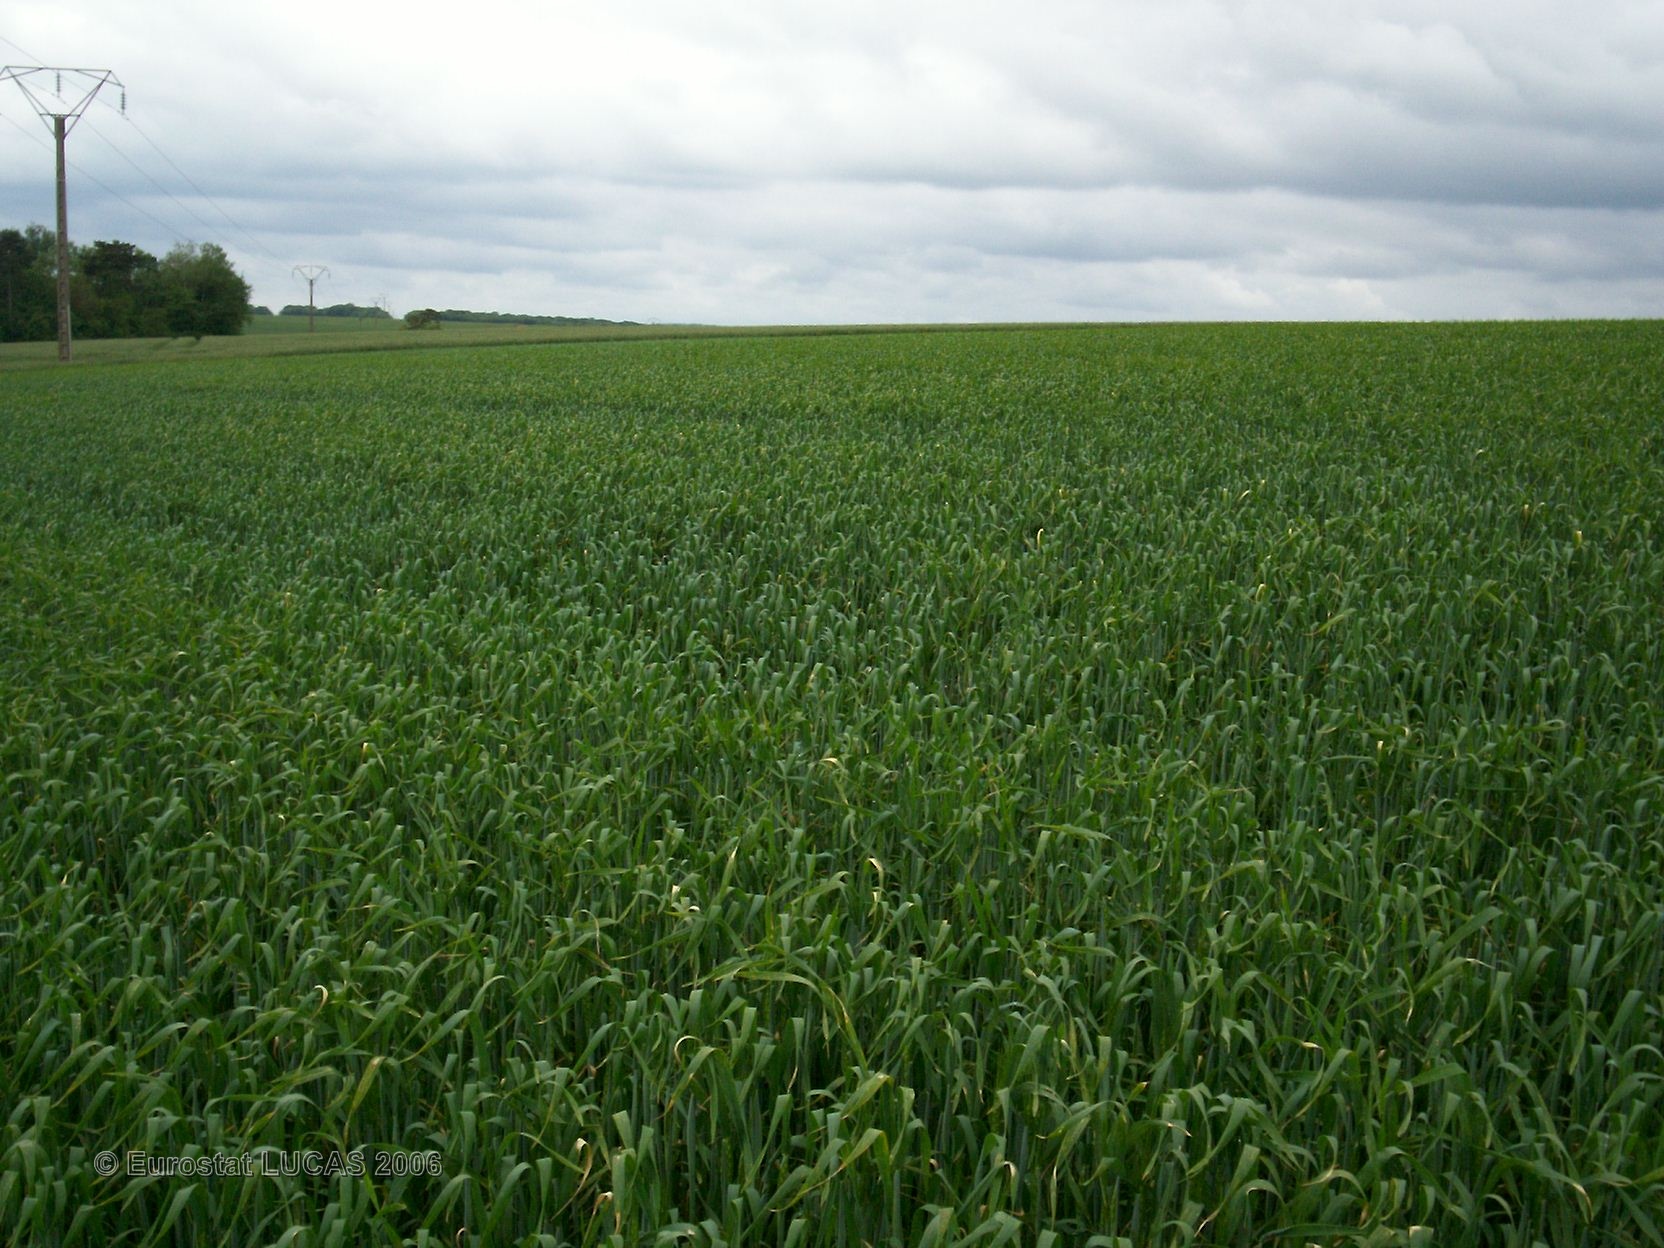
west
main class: Cropland
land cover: Common wheat
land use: Agriculture (excluding fallow land and kitchen gardens)
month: May
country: FR
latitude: 48.2507
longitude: 4.5432
